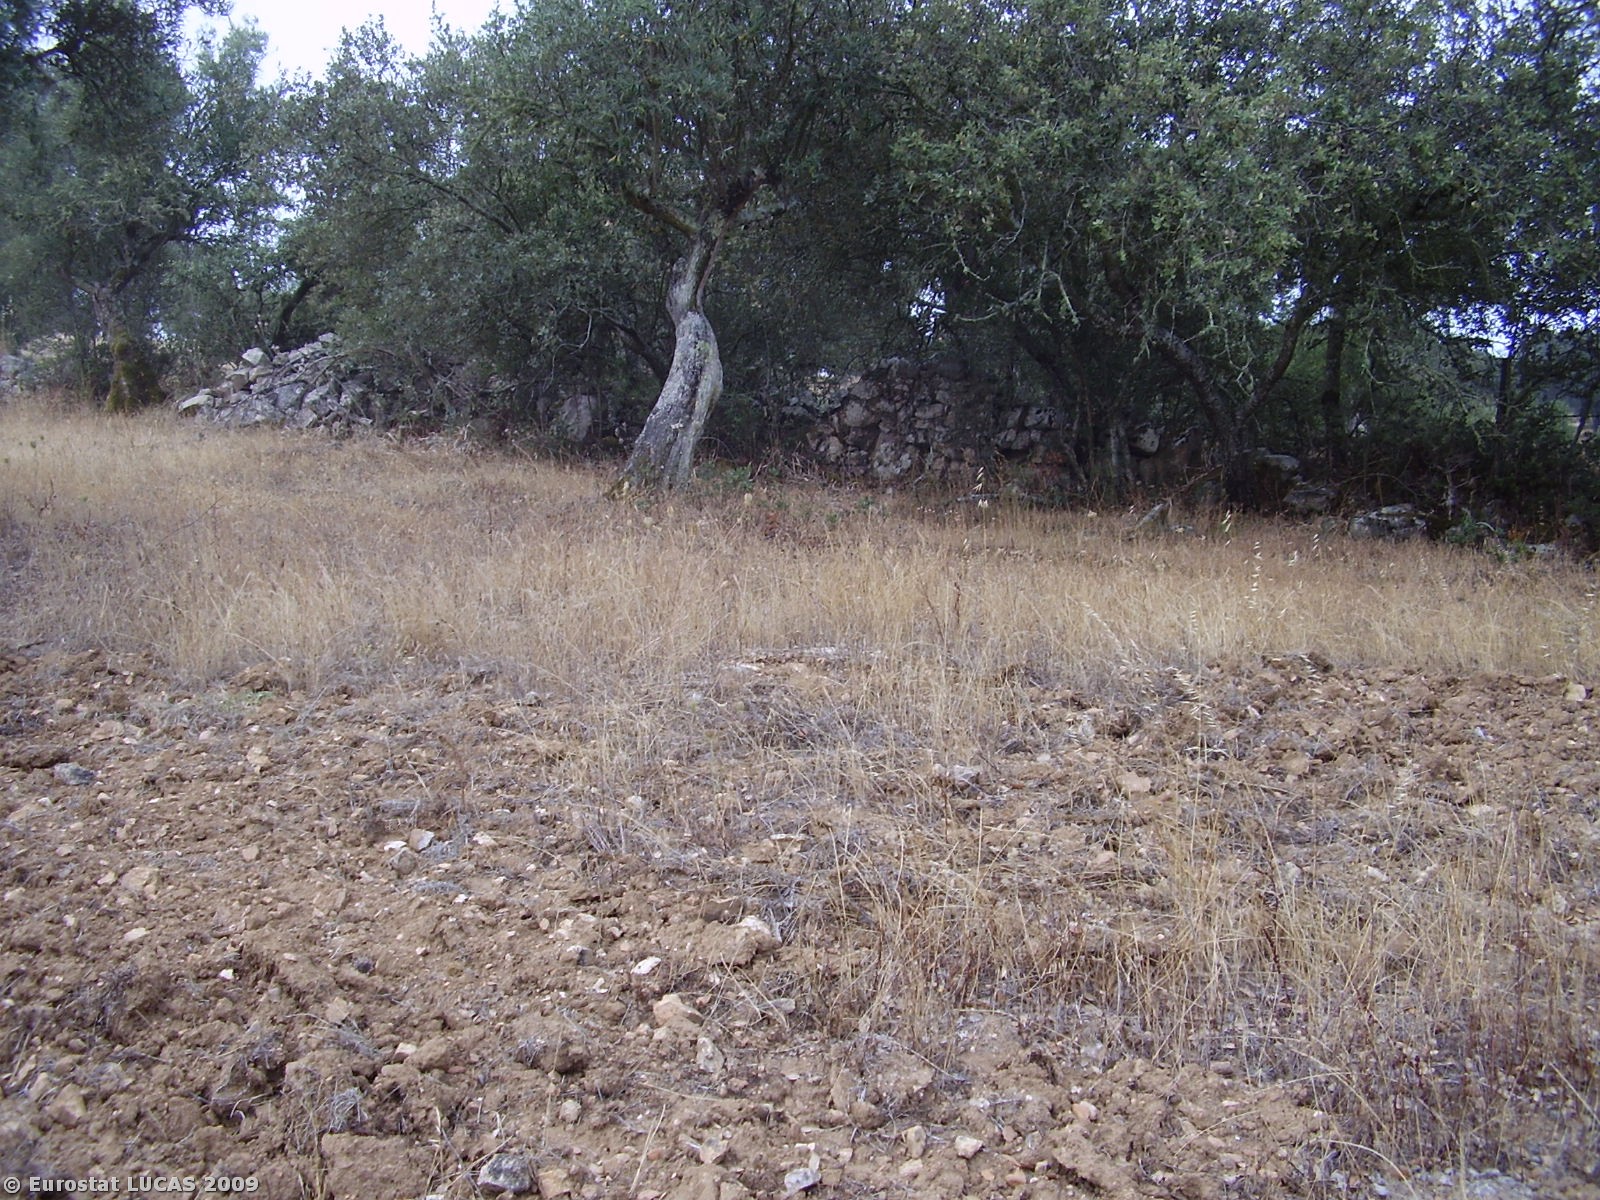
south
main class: Cropland
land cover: Olive groves
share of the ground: 10 - 25 %
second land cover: Spontaneously vegetated surfaces
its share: 50 - 75 %
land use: Agriculture (excluding fallow land and kitchen gardens)
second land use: Fallow land
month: July
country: PT
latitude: 38.8168
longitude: -7.8598
